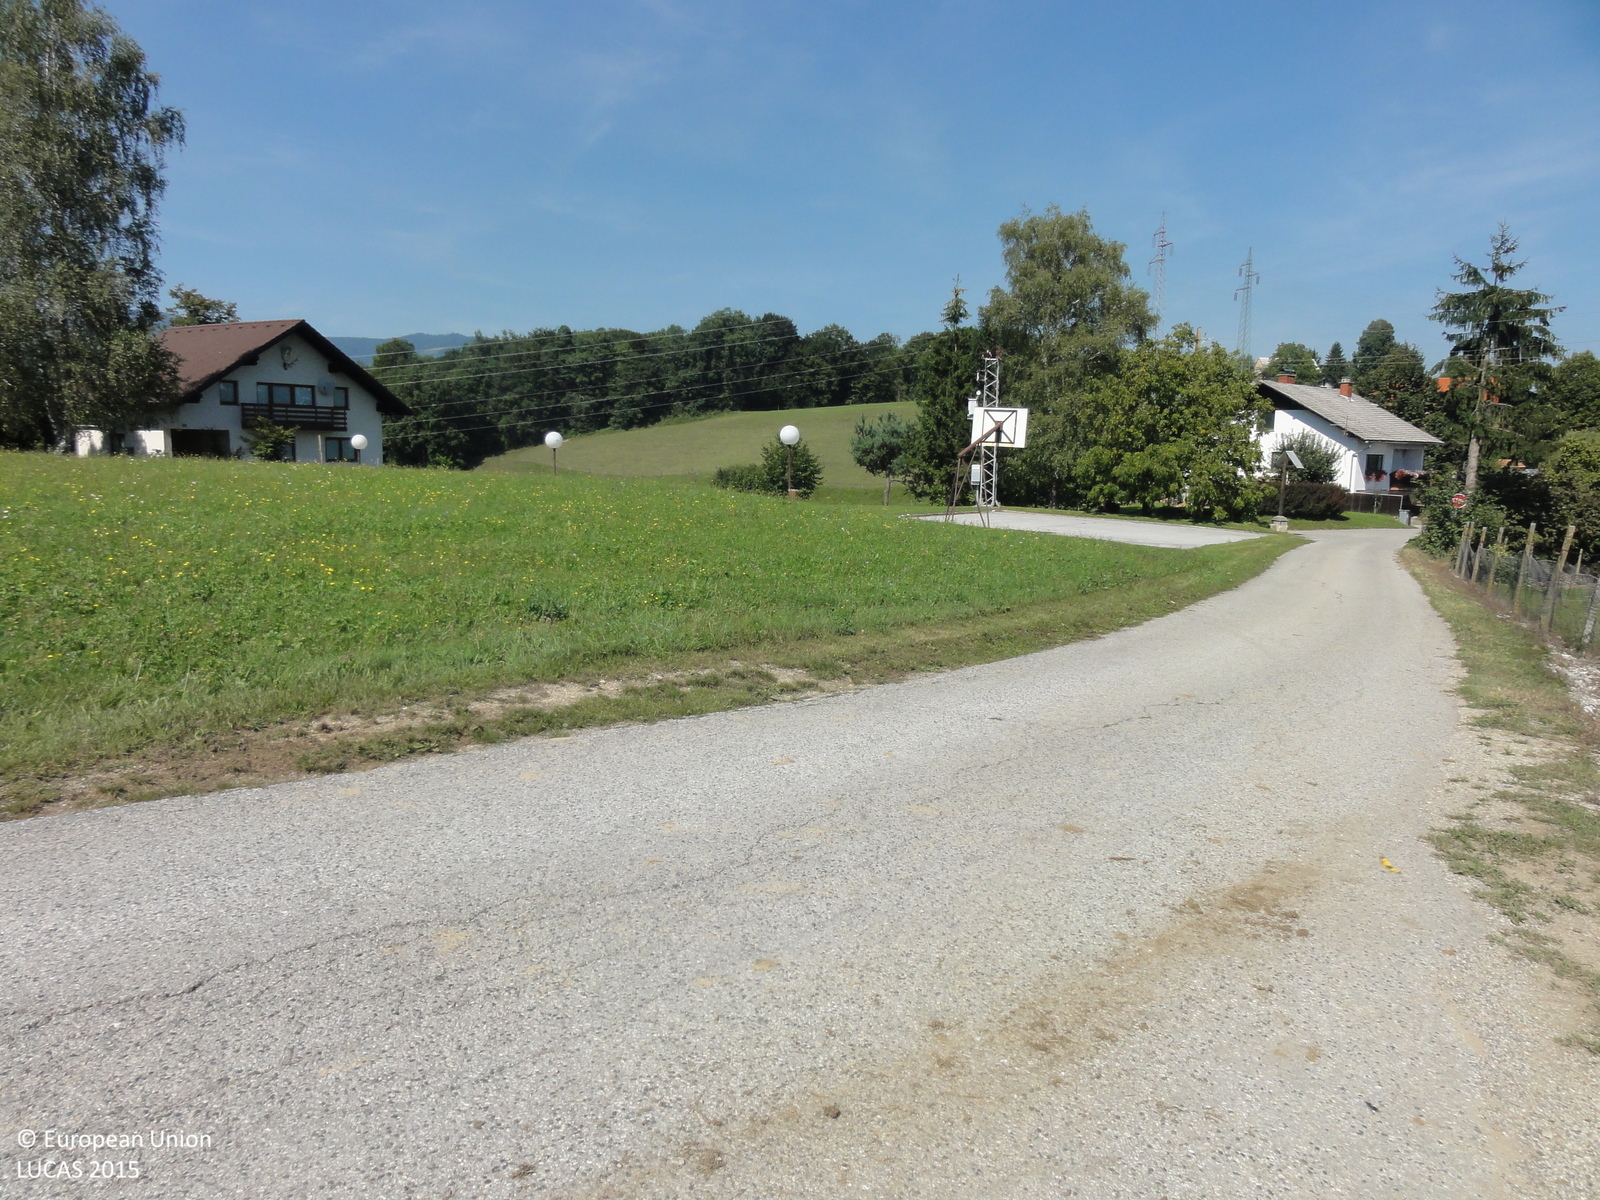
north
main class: Cropland
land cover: Apple fruit
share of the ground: 50 - 75 %
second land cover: Grassland without tree/shrub cover
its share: > 75 %
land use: Agriculture (excluding fallow land and kitchen gardens)
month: August
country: SI
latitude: 45.9952
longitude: 15.4589
